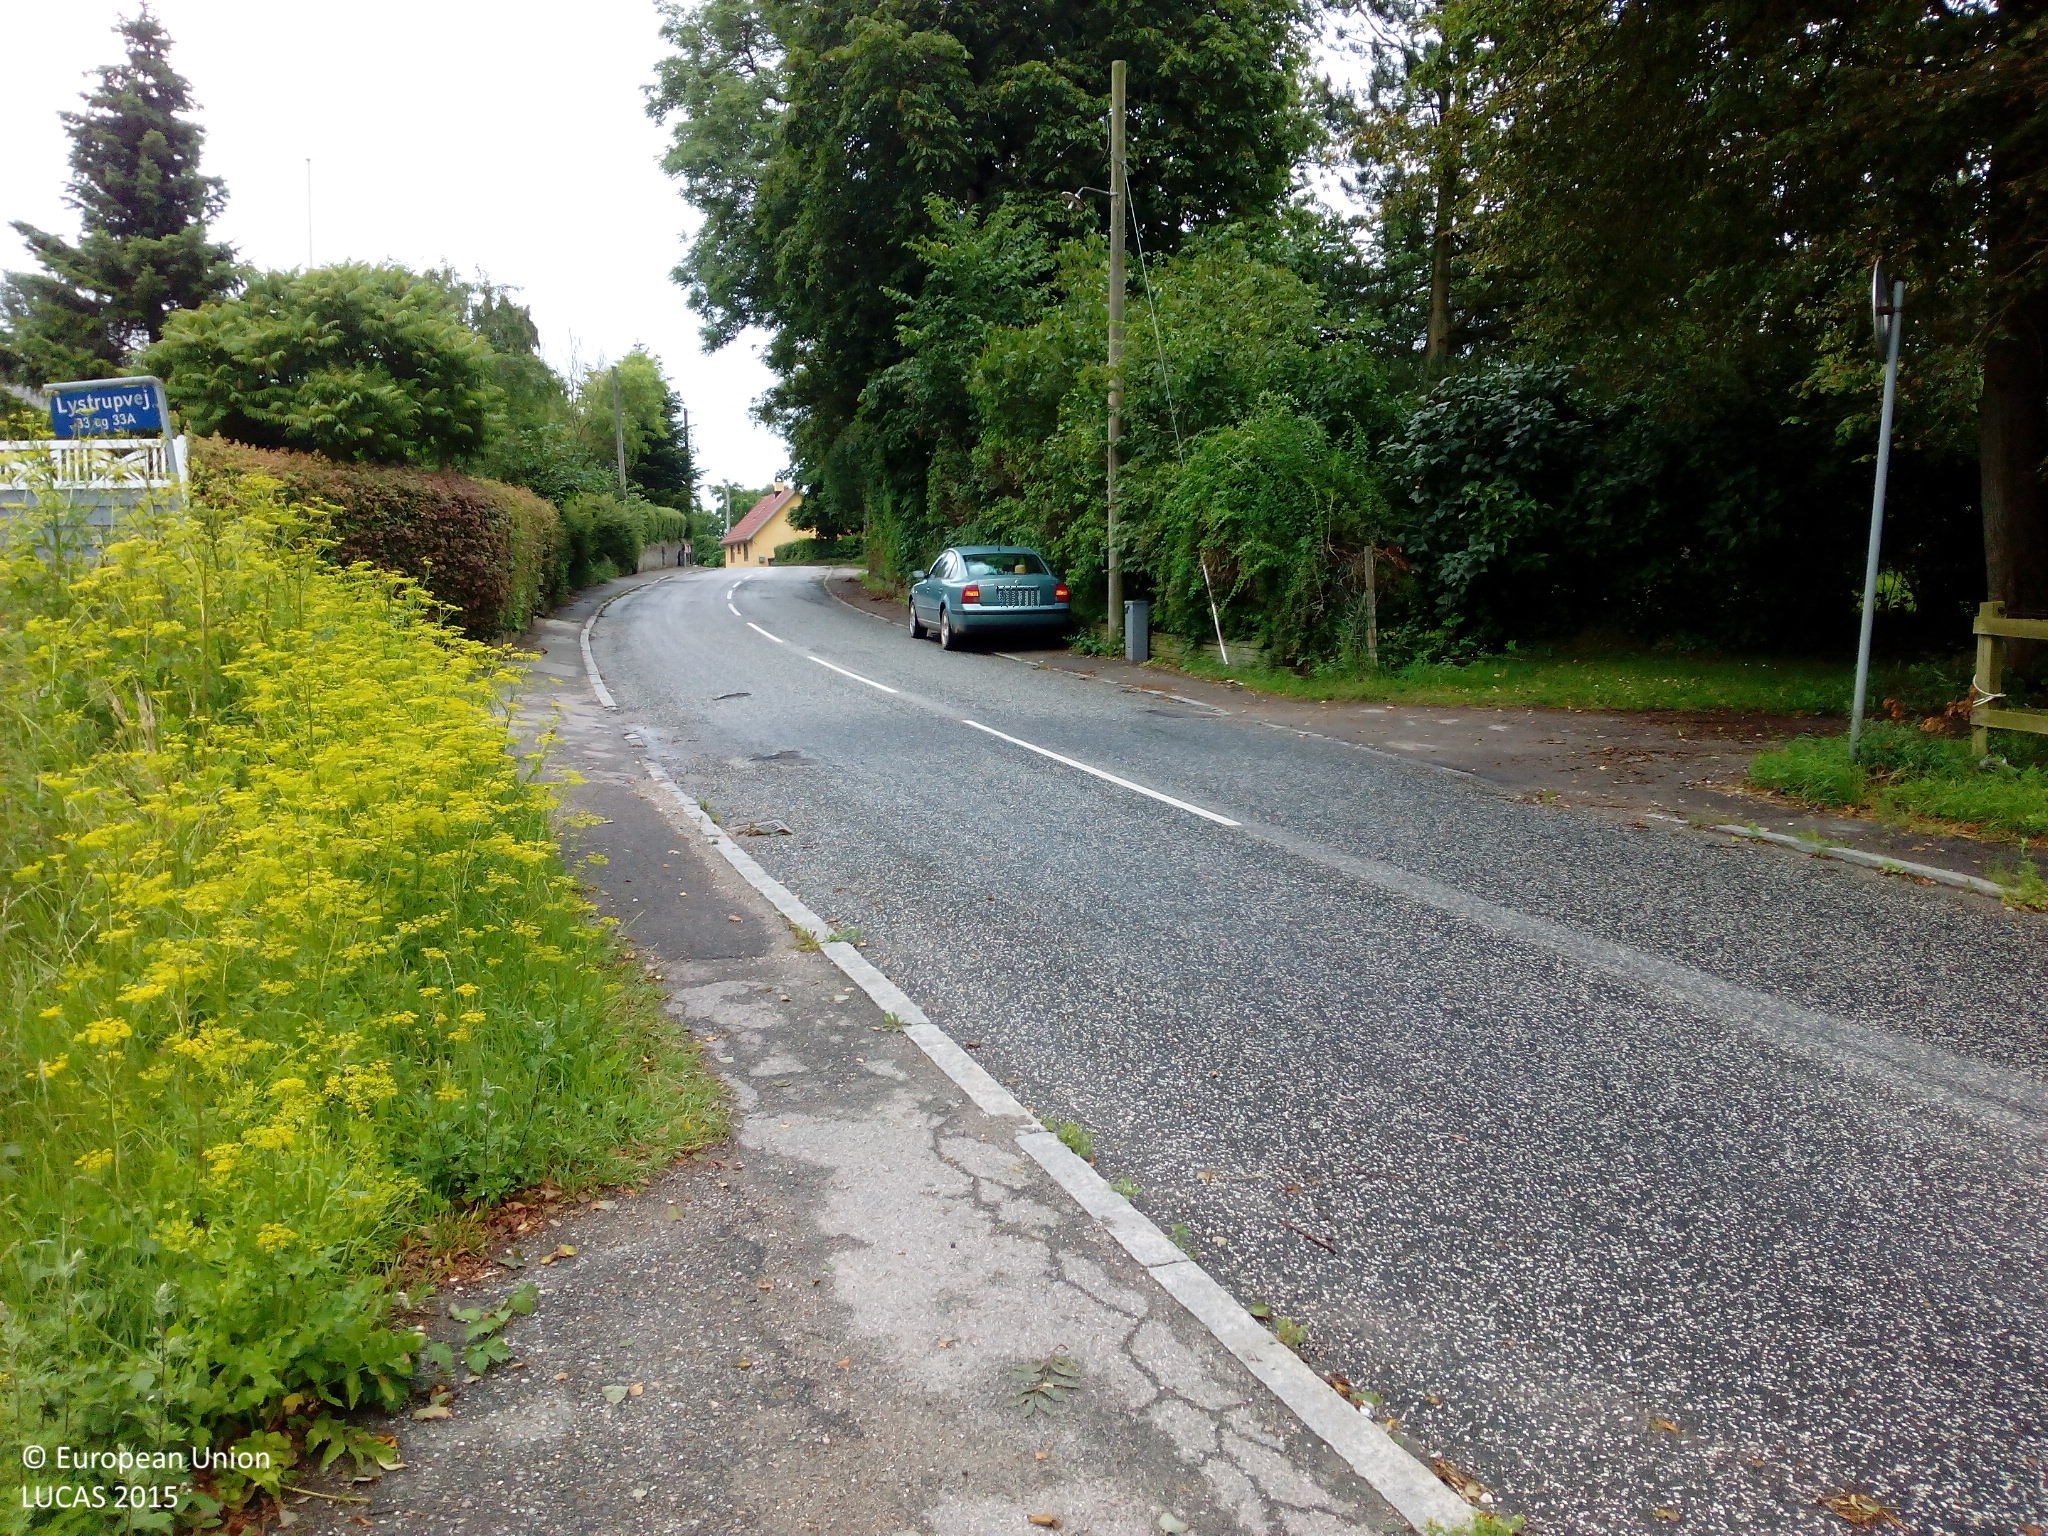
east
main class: Grassland
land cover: Grassland without tree/shrub cover
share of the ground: > 75 %
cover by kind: herbaceous plants 100 %
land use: Agriculture (excluding fallow land and kitchen gardens)
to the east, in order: Grassland without tree/shrub cover; Fences; Broadleaved woodland; Grassland without tree/shrub cover; Broadleaved woodland; Grassland without tree/shrub cover
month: July
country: DK
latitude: 55.8629
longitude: 12.2189
